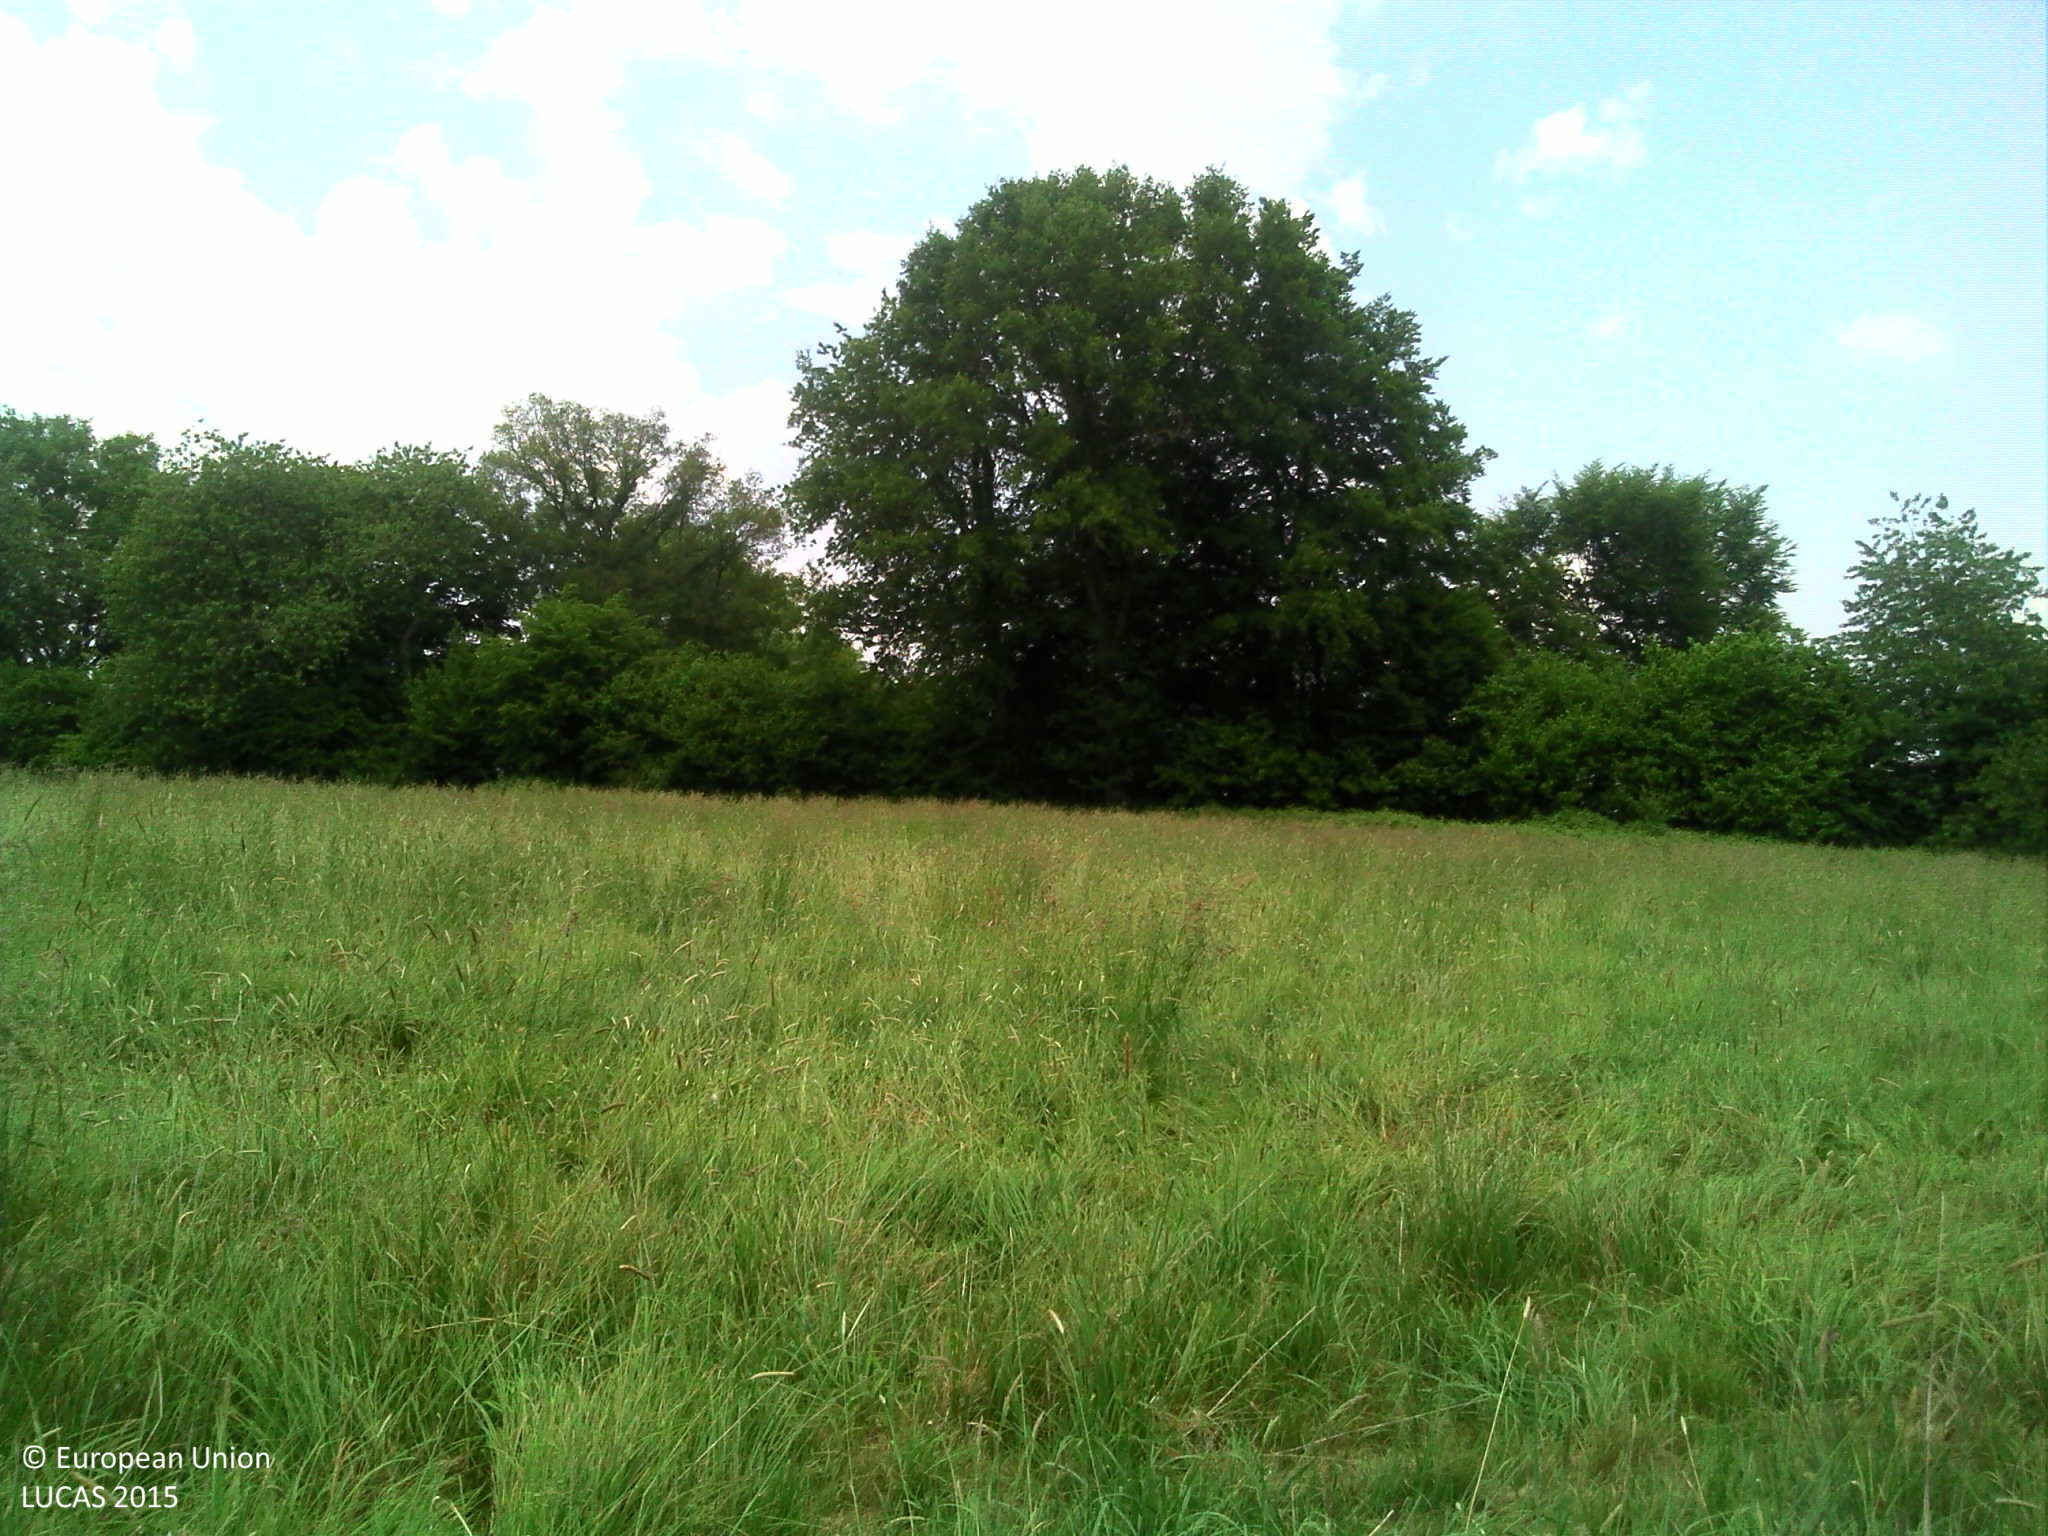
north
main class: Grassland
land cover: Grassland without tree/shrub cover
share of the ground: > 75 %
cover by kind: herbaceous plants 95 %
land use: Agriculture (excluding fallow land and kitchen gardens)
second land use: Forestry
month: June
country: FR
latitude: 48.6900
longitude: 0.1772
